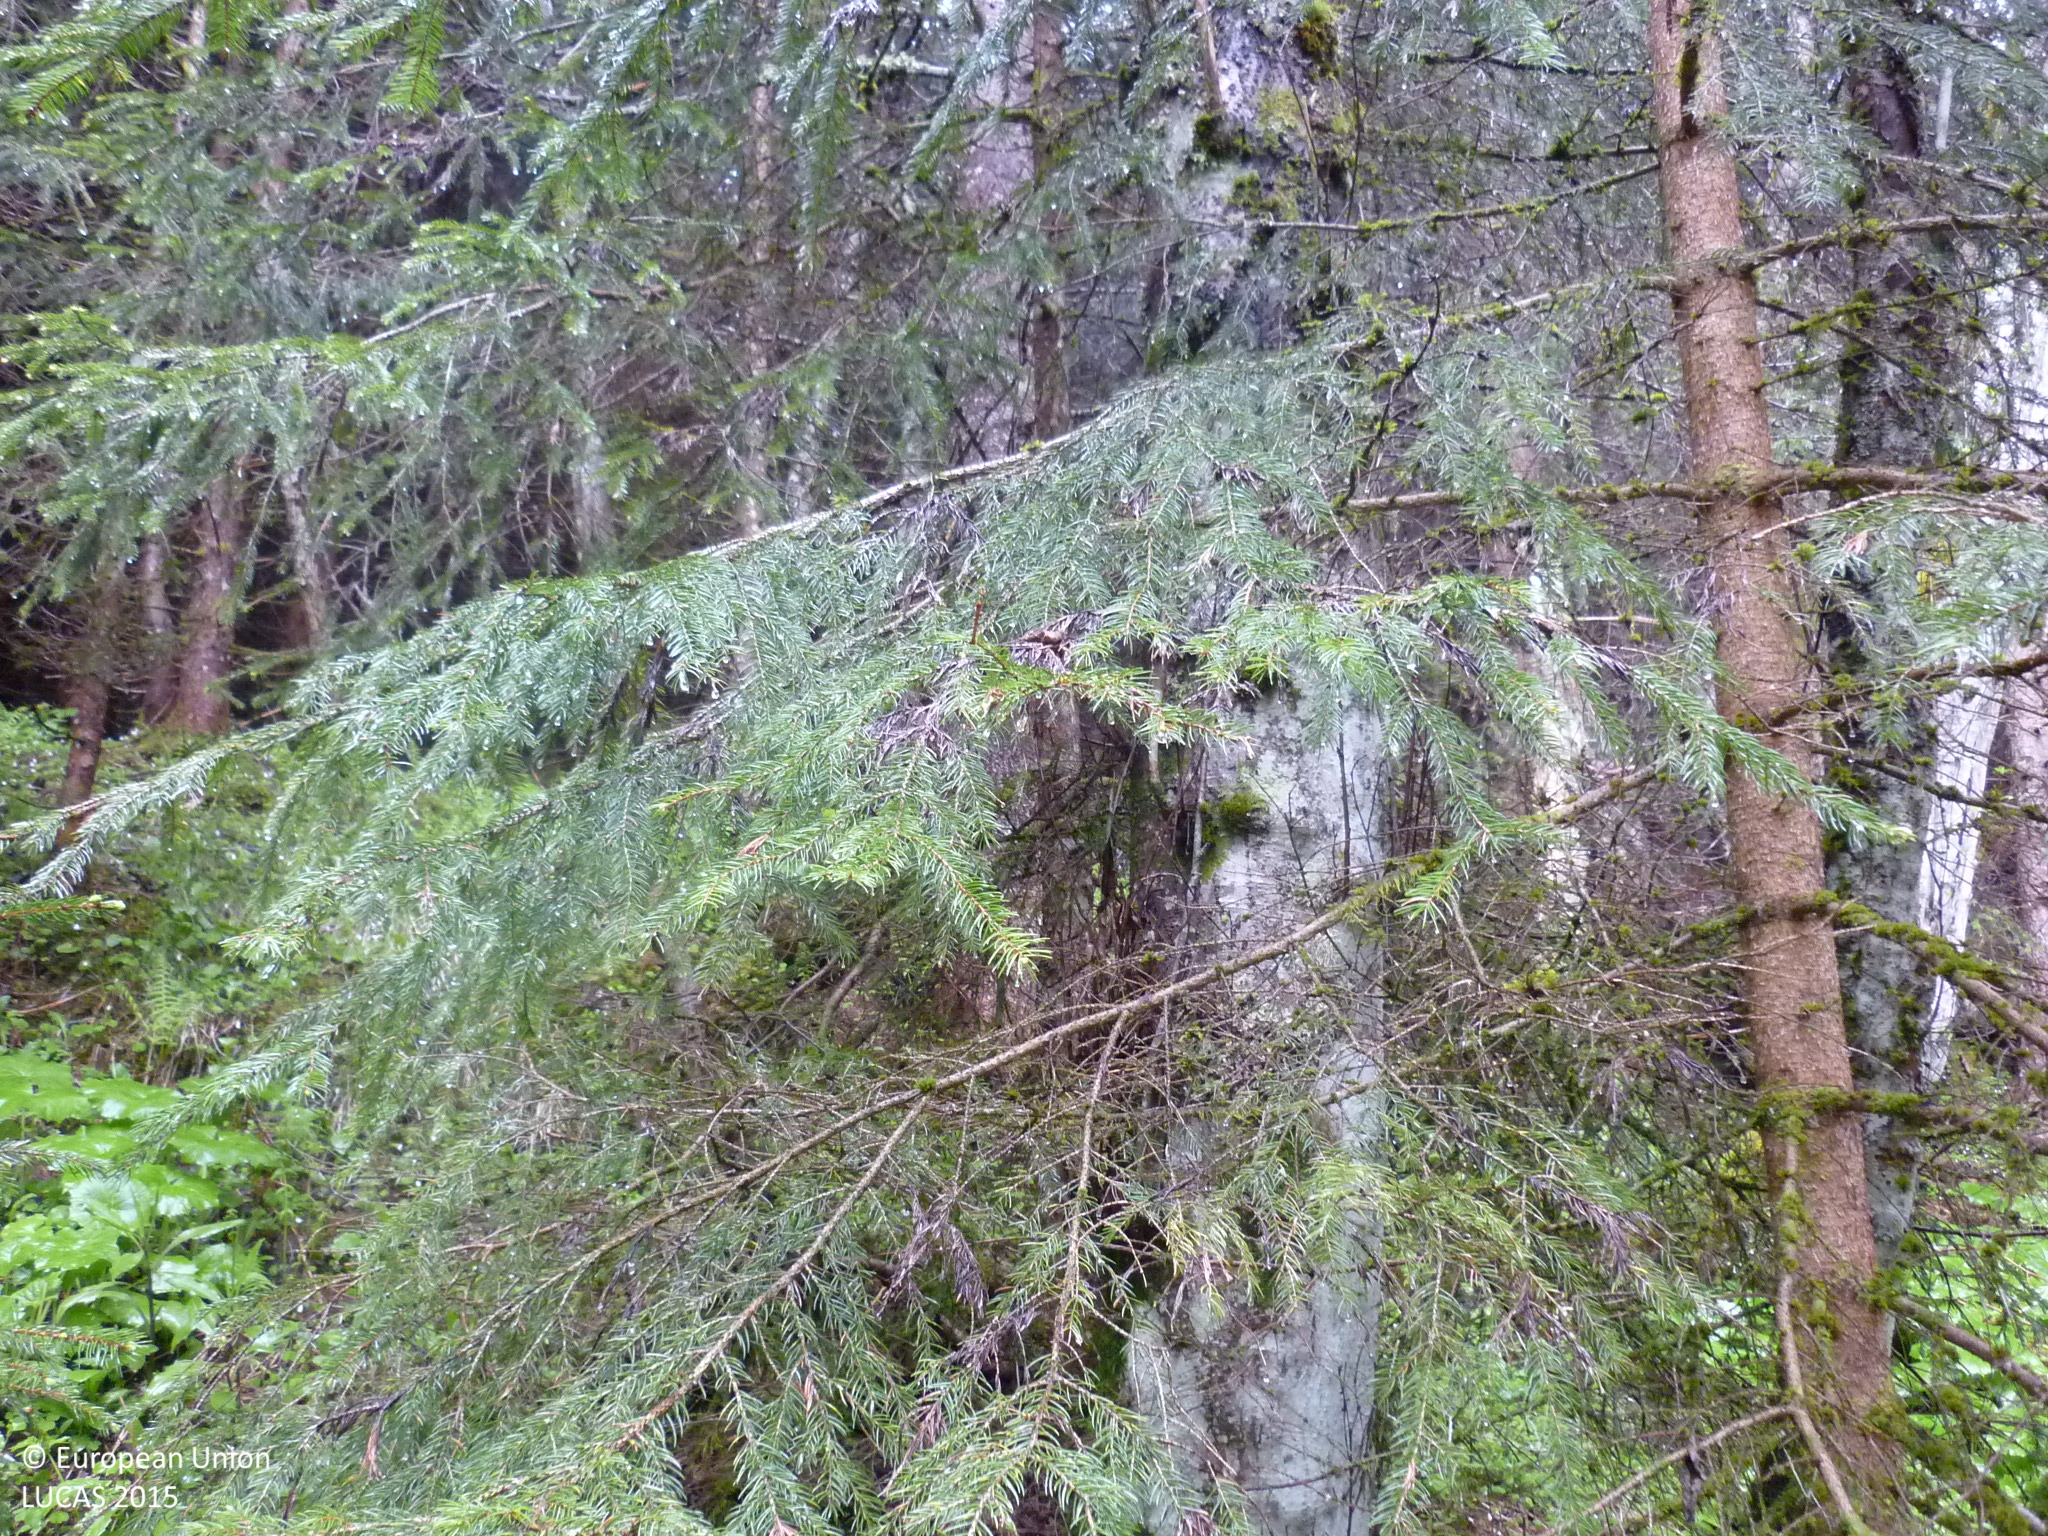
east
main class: Woodland
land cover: Spruce dominated coniferous woodland
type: alpine coniferous forest
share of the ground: > 75 %
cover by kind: coniferous forest trees 70 %, broadleaved forest trees 15 %, herbaceous plants 15 %
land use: Forestry
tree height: > 5 m
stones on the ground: < 10 %
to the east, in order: Spruce dominated coniferous woodland; Spruce dominated mixed woodland; Spontaneously vegetated surfaces; Fences; Grassland without tree/shrub cover; Tracks; Grassland with sparse tree/shrub cover
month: May
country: AT
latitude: 47.3518
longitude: 14.1686
